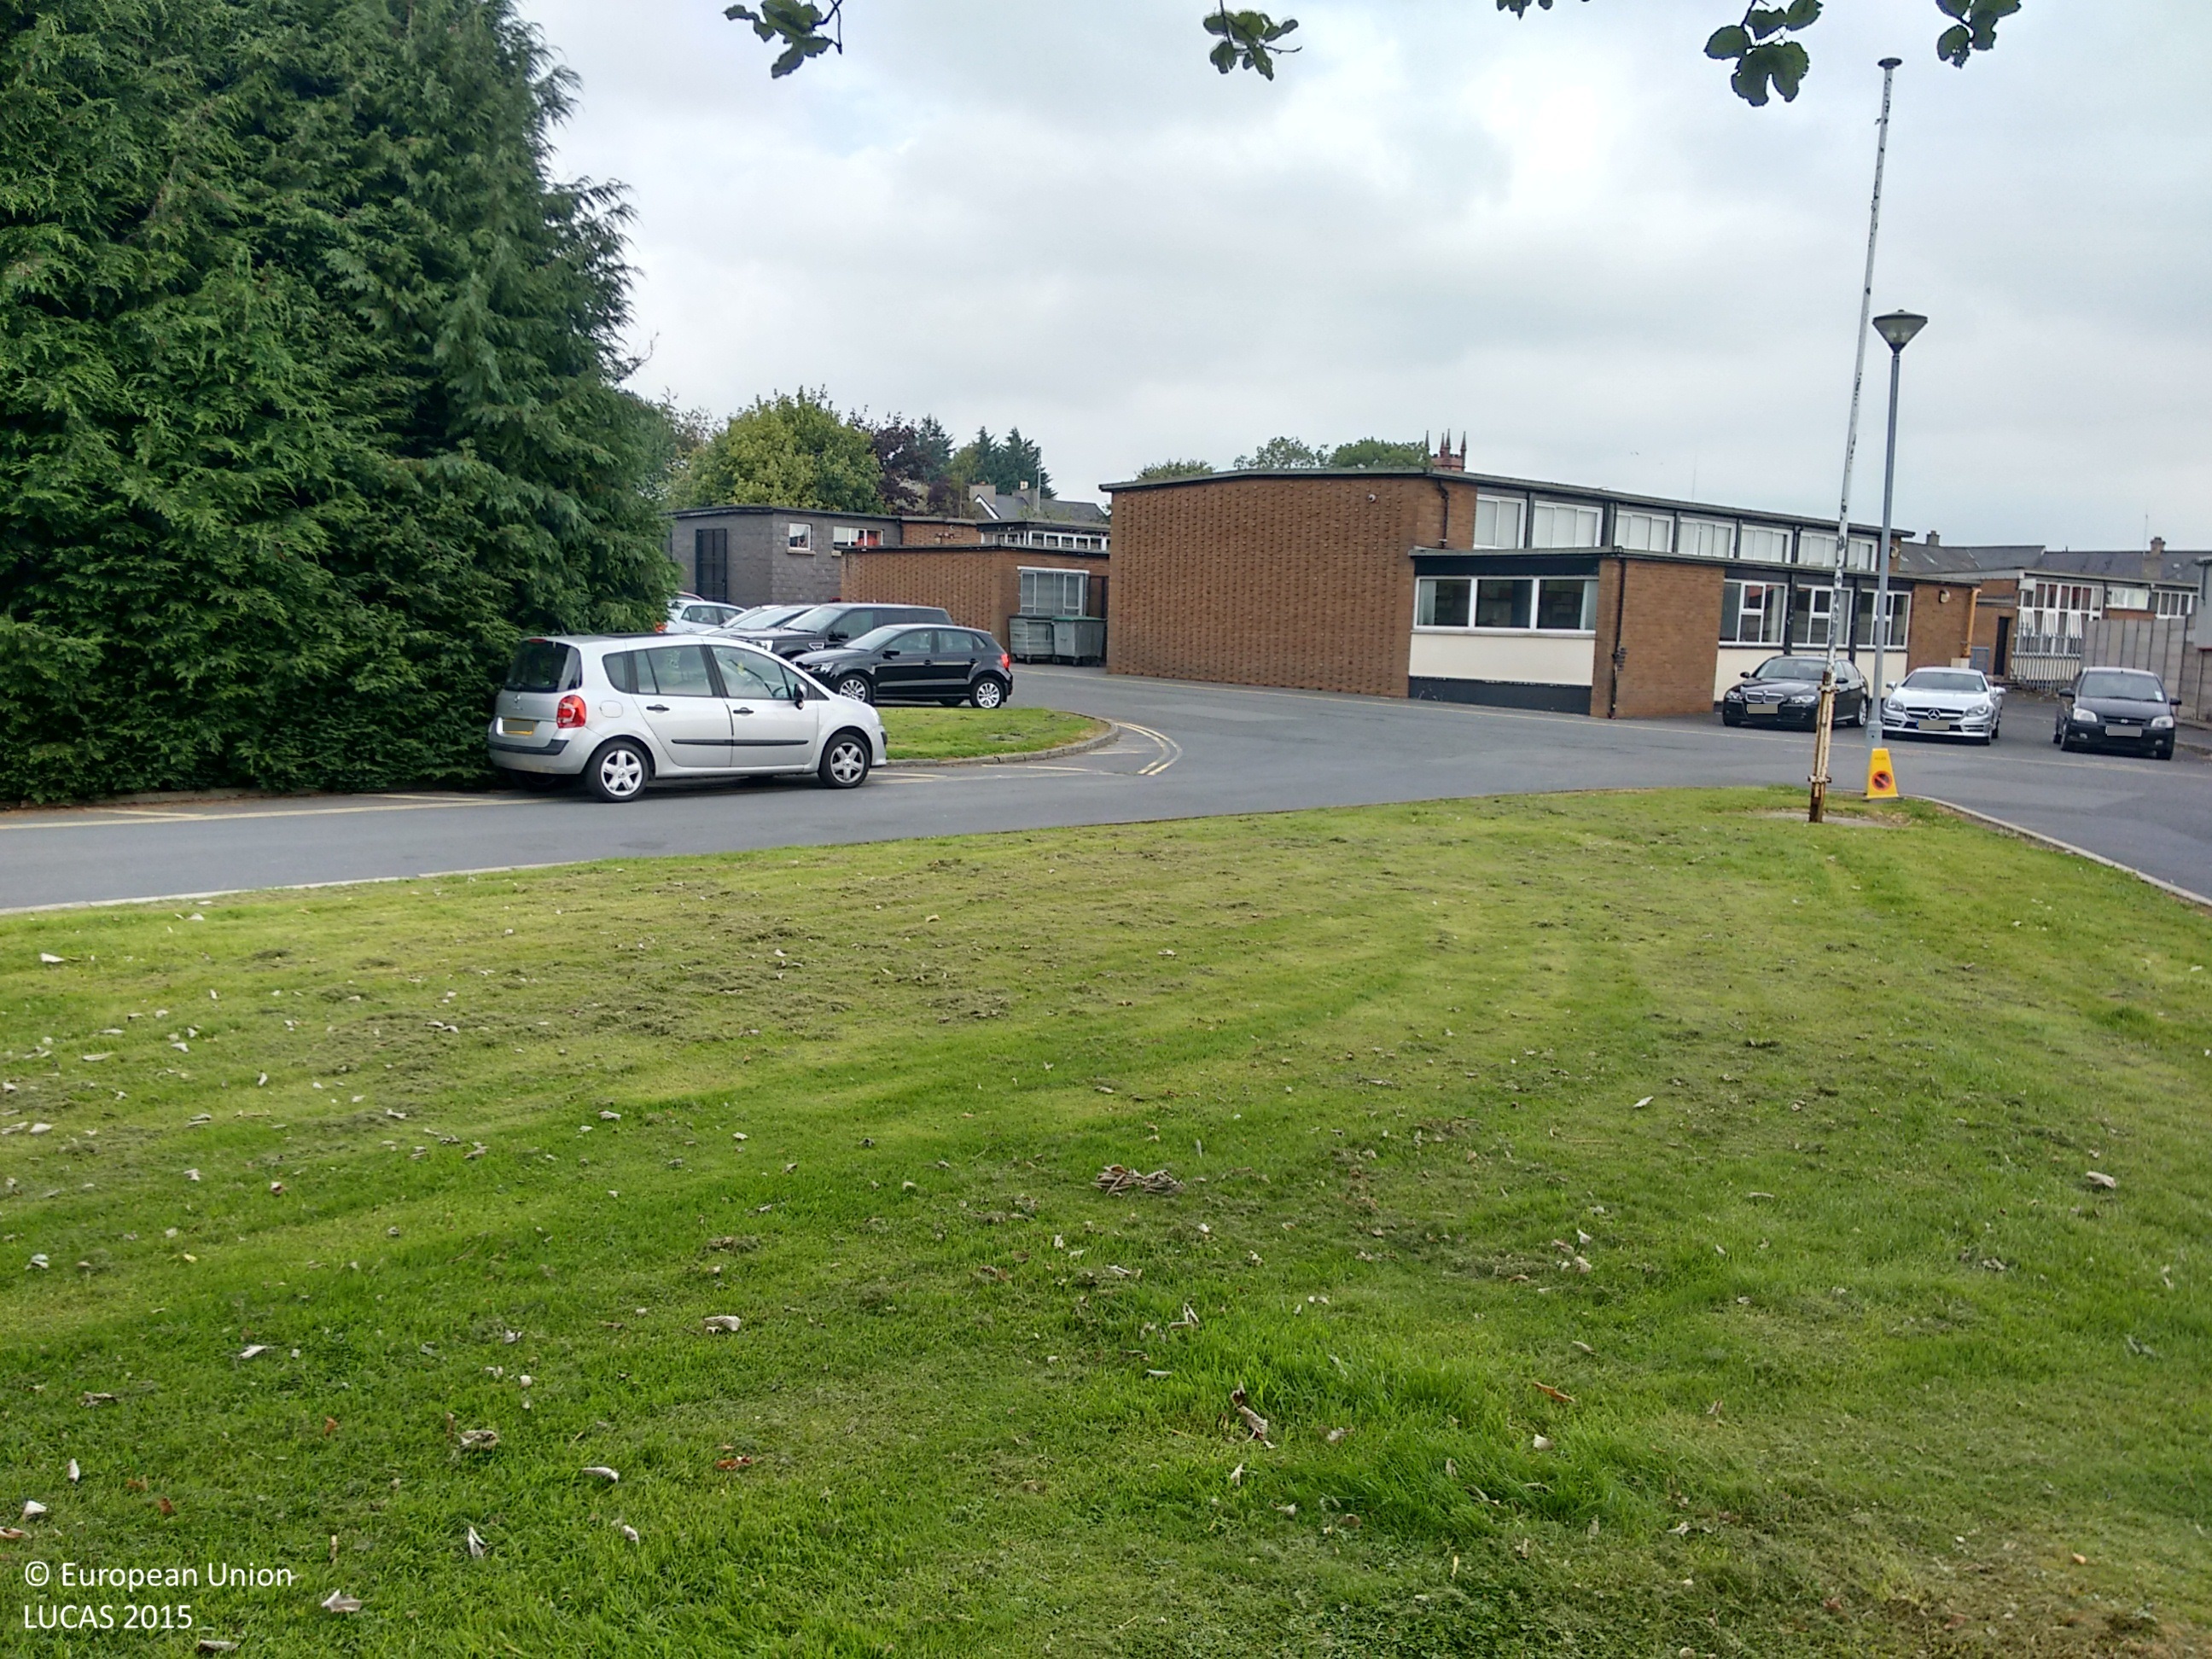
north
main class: Grassland
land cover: Grassland with sparse tree/shrub cover
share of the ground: > 75 %
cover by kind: herbaceous plants 50 %, broadleaved forest trees 5 %
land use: Community services
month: September
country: GB
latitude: 54.7510
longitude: -6.0034
